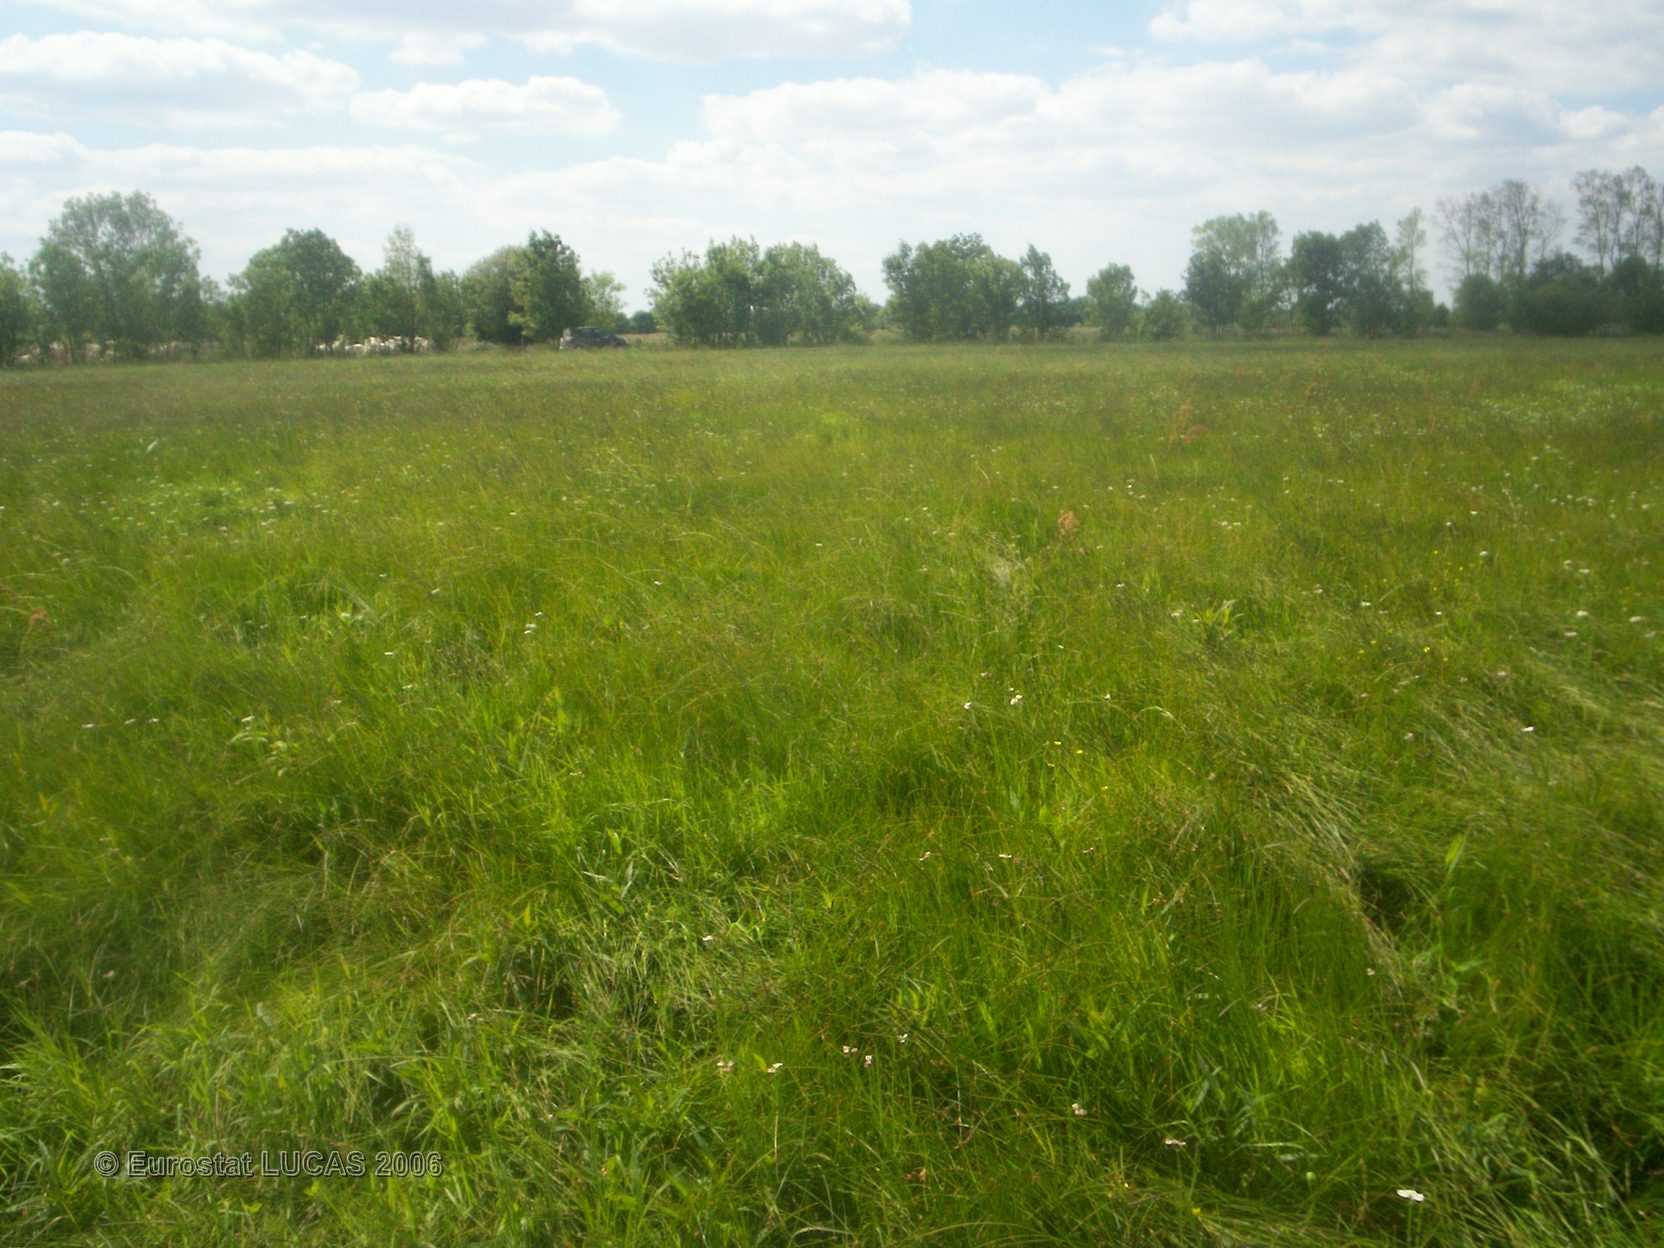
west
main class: Grassland
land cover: Grassland without tree/shrub cover
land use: Agriculture (excluding fallow land and kitchen gardens)
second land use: Wetland
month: May
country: FR
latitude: 45.8922
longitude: -0.8135
